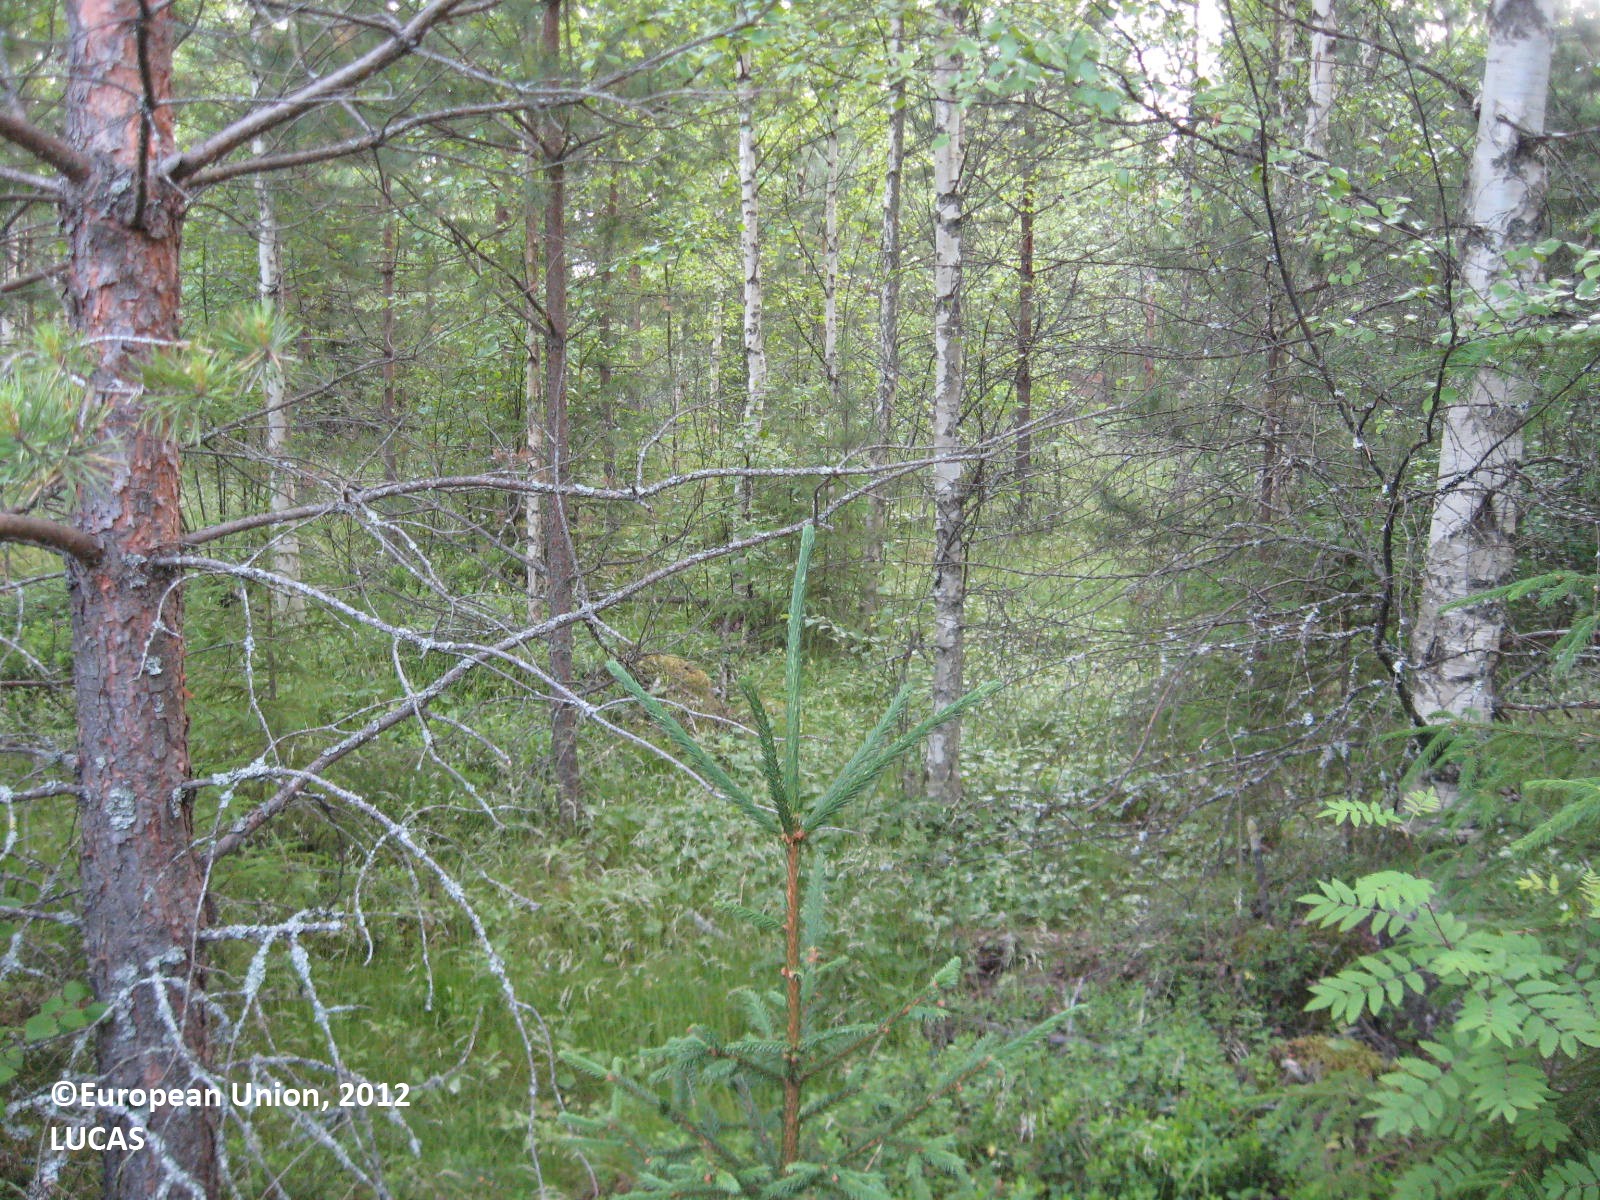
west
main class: Woodland
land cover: Pine dominated mixed woodland
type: boreal forest
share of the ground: > 75 %
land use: Forestry
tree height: > 5 m
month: July
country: FI
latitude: 62.5885
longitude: 22.6544
